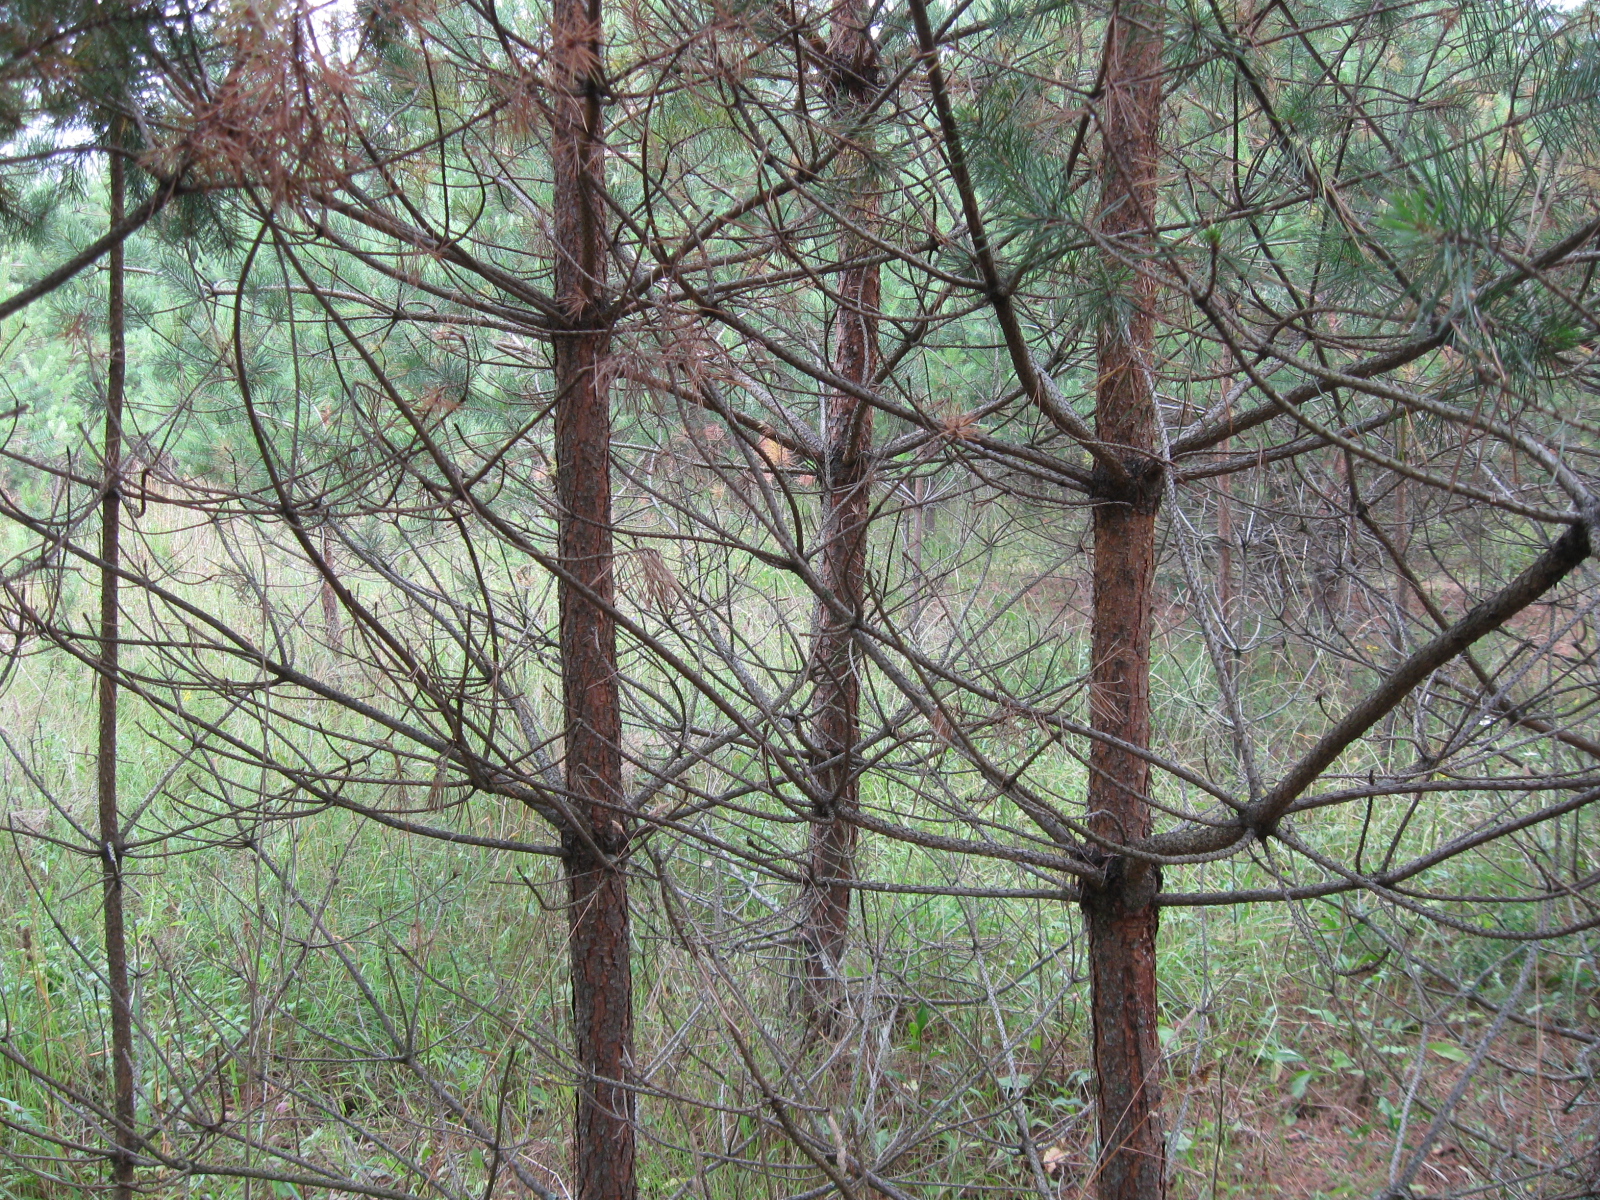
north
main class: Woodland
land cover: Pine dominated coniferous woodland
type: hemiboreal forest and nemoral coniferous forest and mixed broadleaved-coniferous forest
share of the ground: 50 - 75 %
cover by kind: coniferous forest trees 70 %, herbaceous plants 25 %, unconsolidated bare surface 5 %
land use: Forestry
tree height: < 5 m
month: July
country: LT
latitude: 54.4058
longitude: 24.3504
